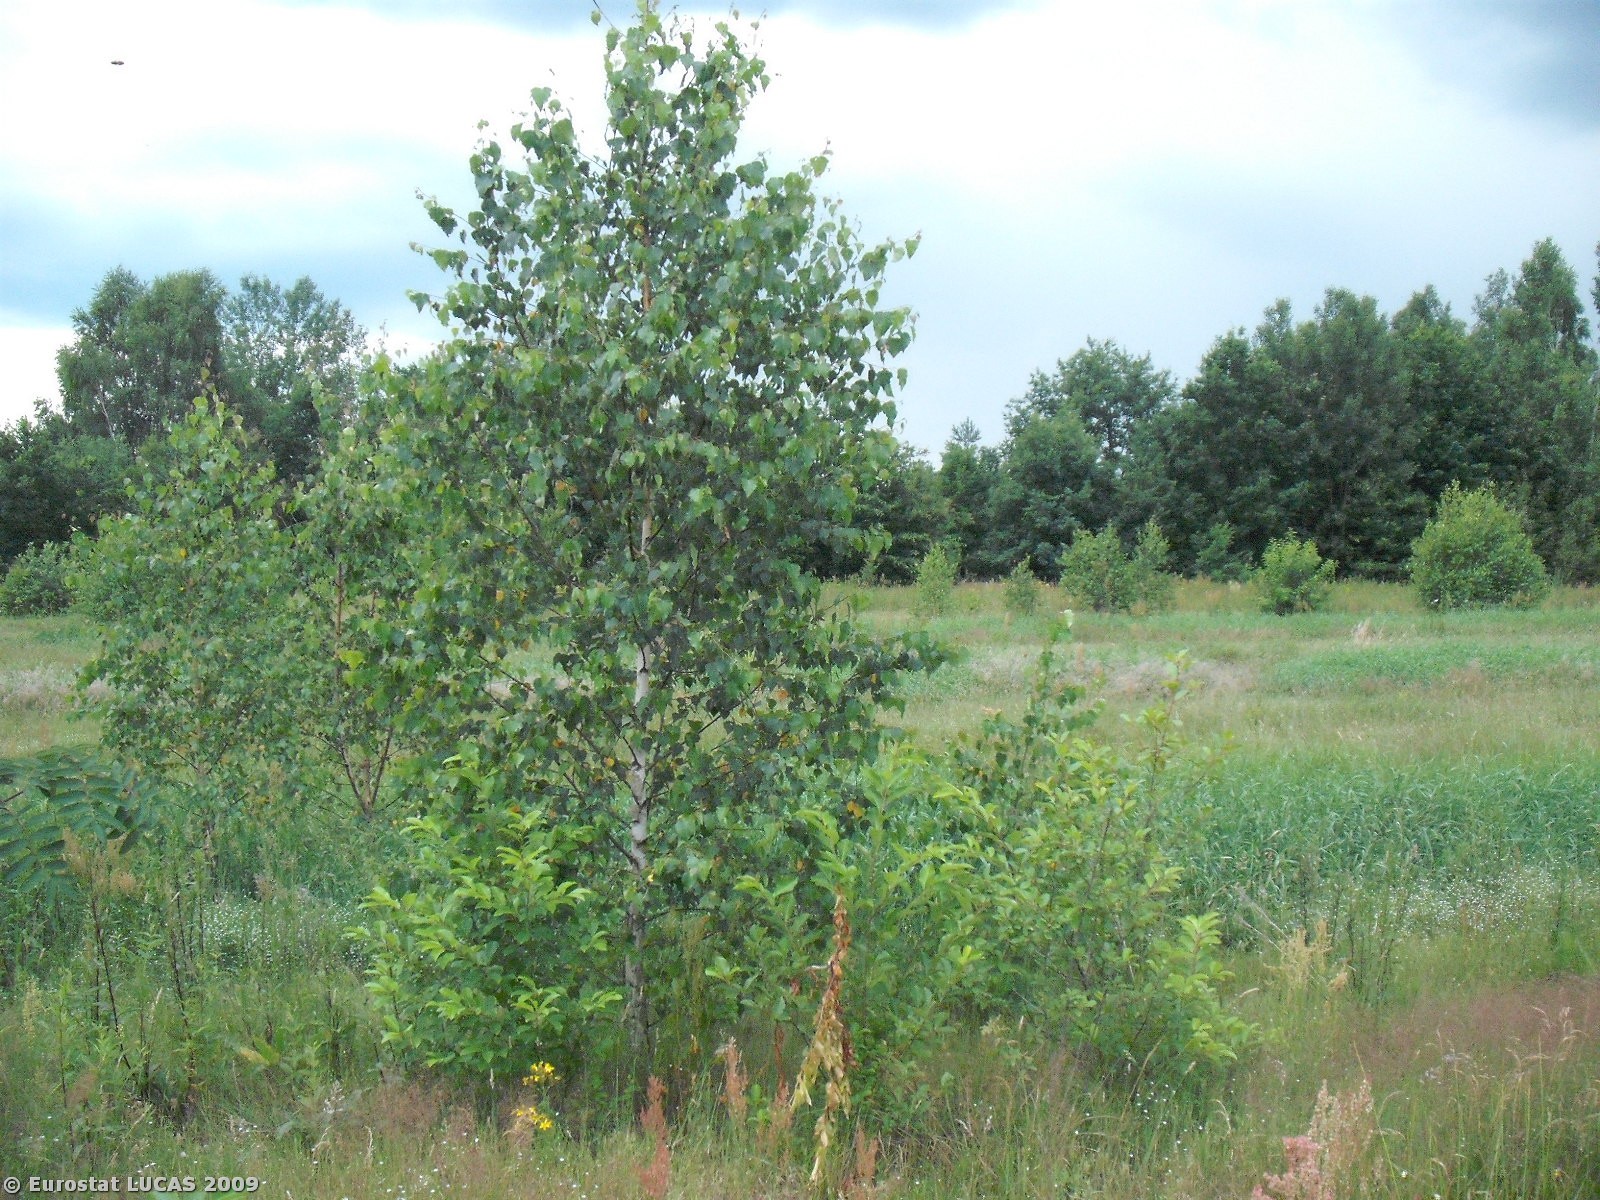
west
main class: Grassland
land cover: Spontaneously vegetated surfaces
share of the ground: > 75 %
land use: Unused
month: July
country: PL
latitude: 51.6331
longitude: 20.9519
